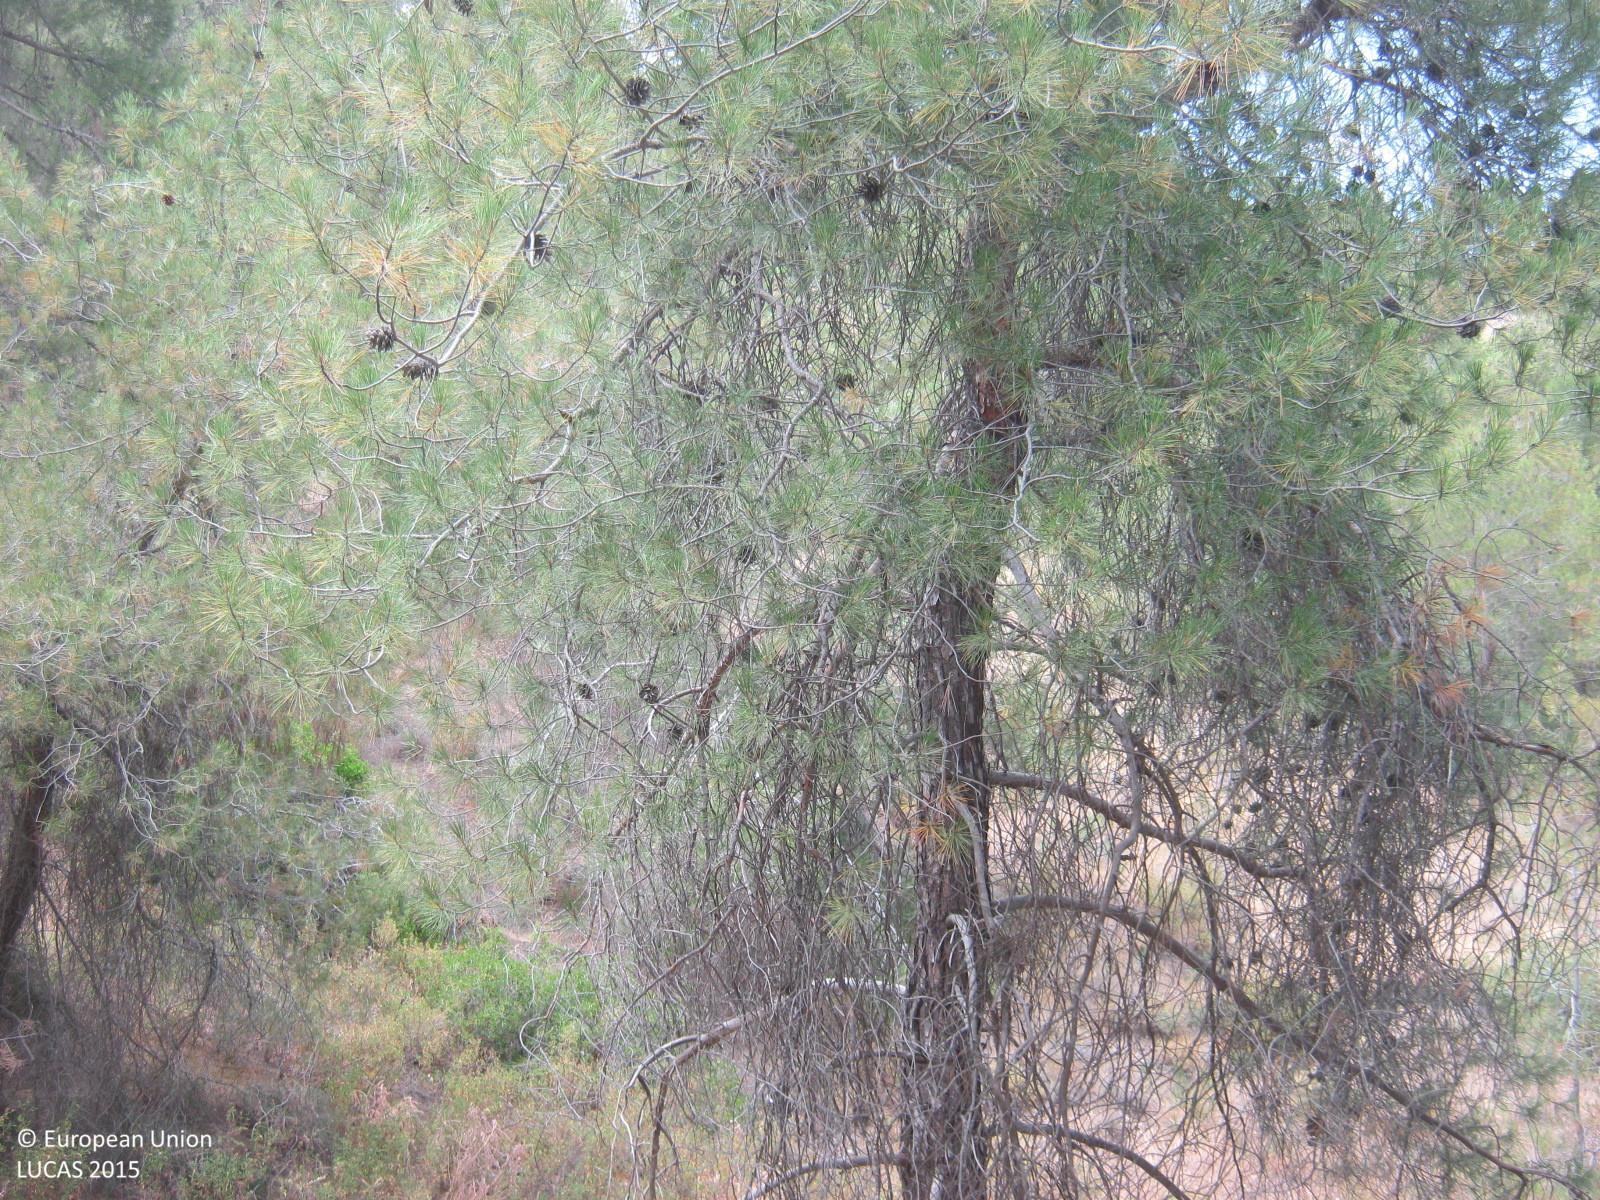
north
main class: Woodland
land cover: Pine dominated coniferous woodland
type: coniferous forest of the mediterranean region
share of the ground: 50 - 75 %
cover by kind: coniferous forest trees 60 %, shrubs 20 %, herbaceous plants 10 %, unconsolidated bare surface 10 %
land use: Forestry
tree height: > 5 m
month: June
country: CY
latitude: 34.9752
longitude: 33.1711
